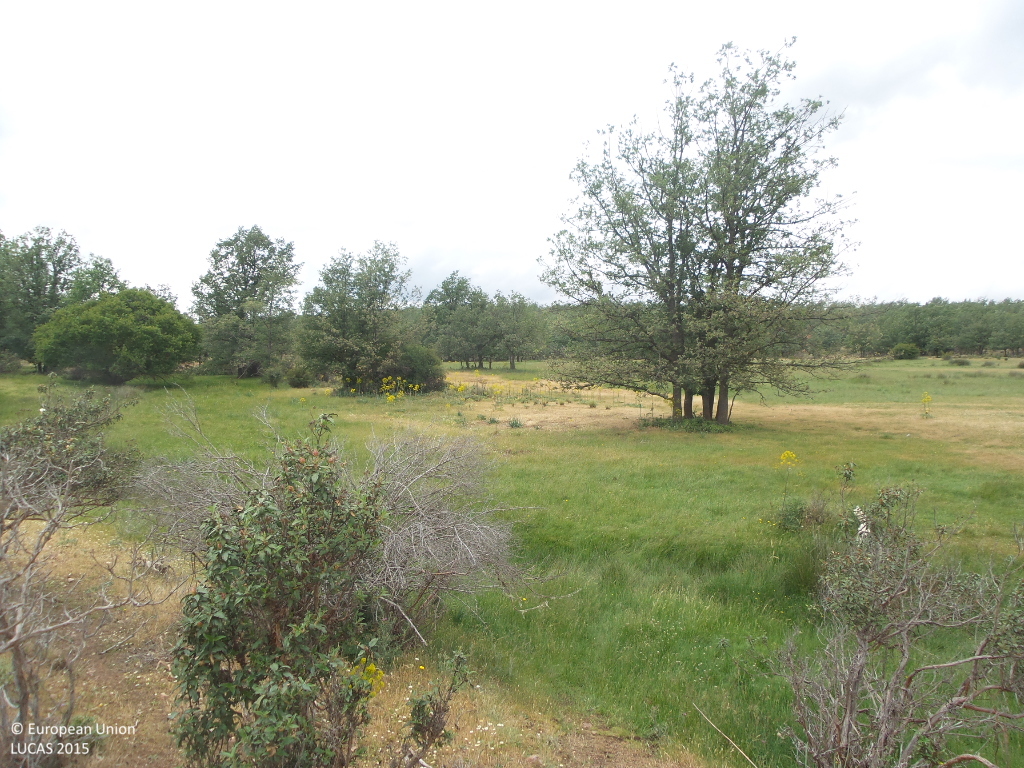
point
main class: Grassland
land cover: Grassland with sparse tree/shrub cover
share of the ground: > 75 %
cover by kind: herbaceous plants 95 %, broadleaved forest trees 5 %
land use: Agriculture (excluding fallow land and kitchen gardens)
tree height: > 5 m
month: June
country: ES
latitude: 41.3178
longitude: -3.1461
